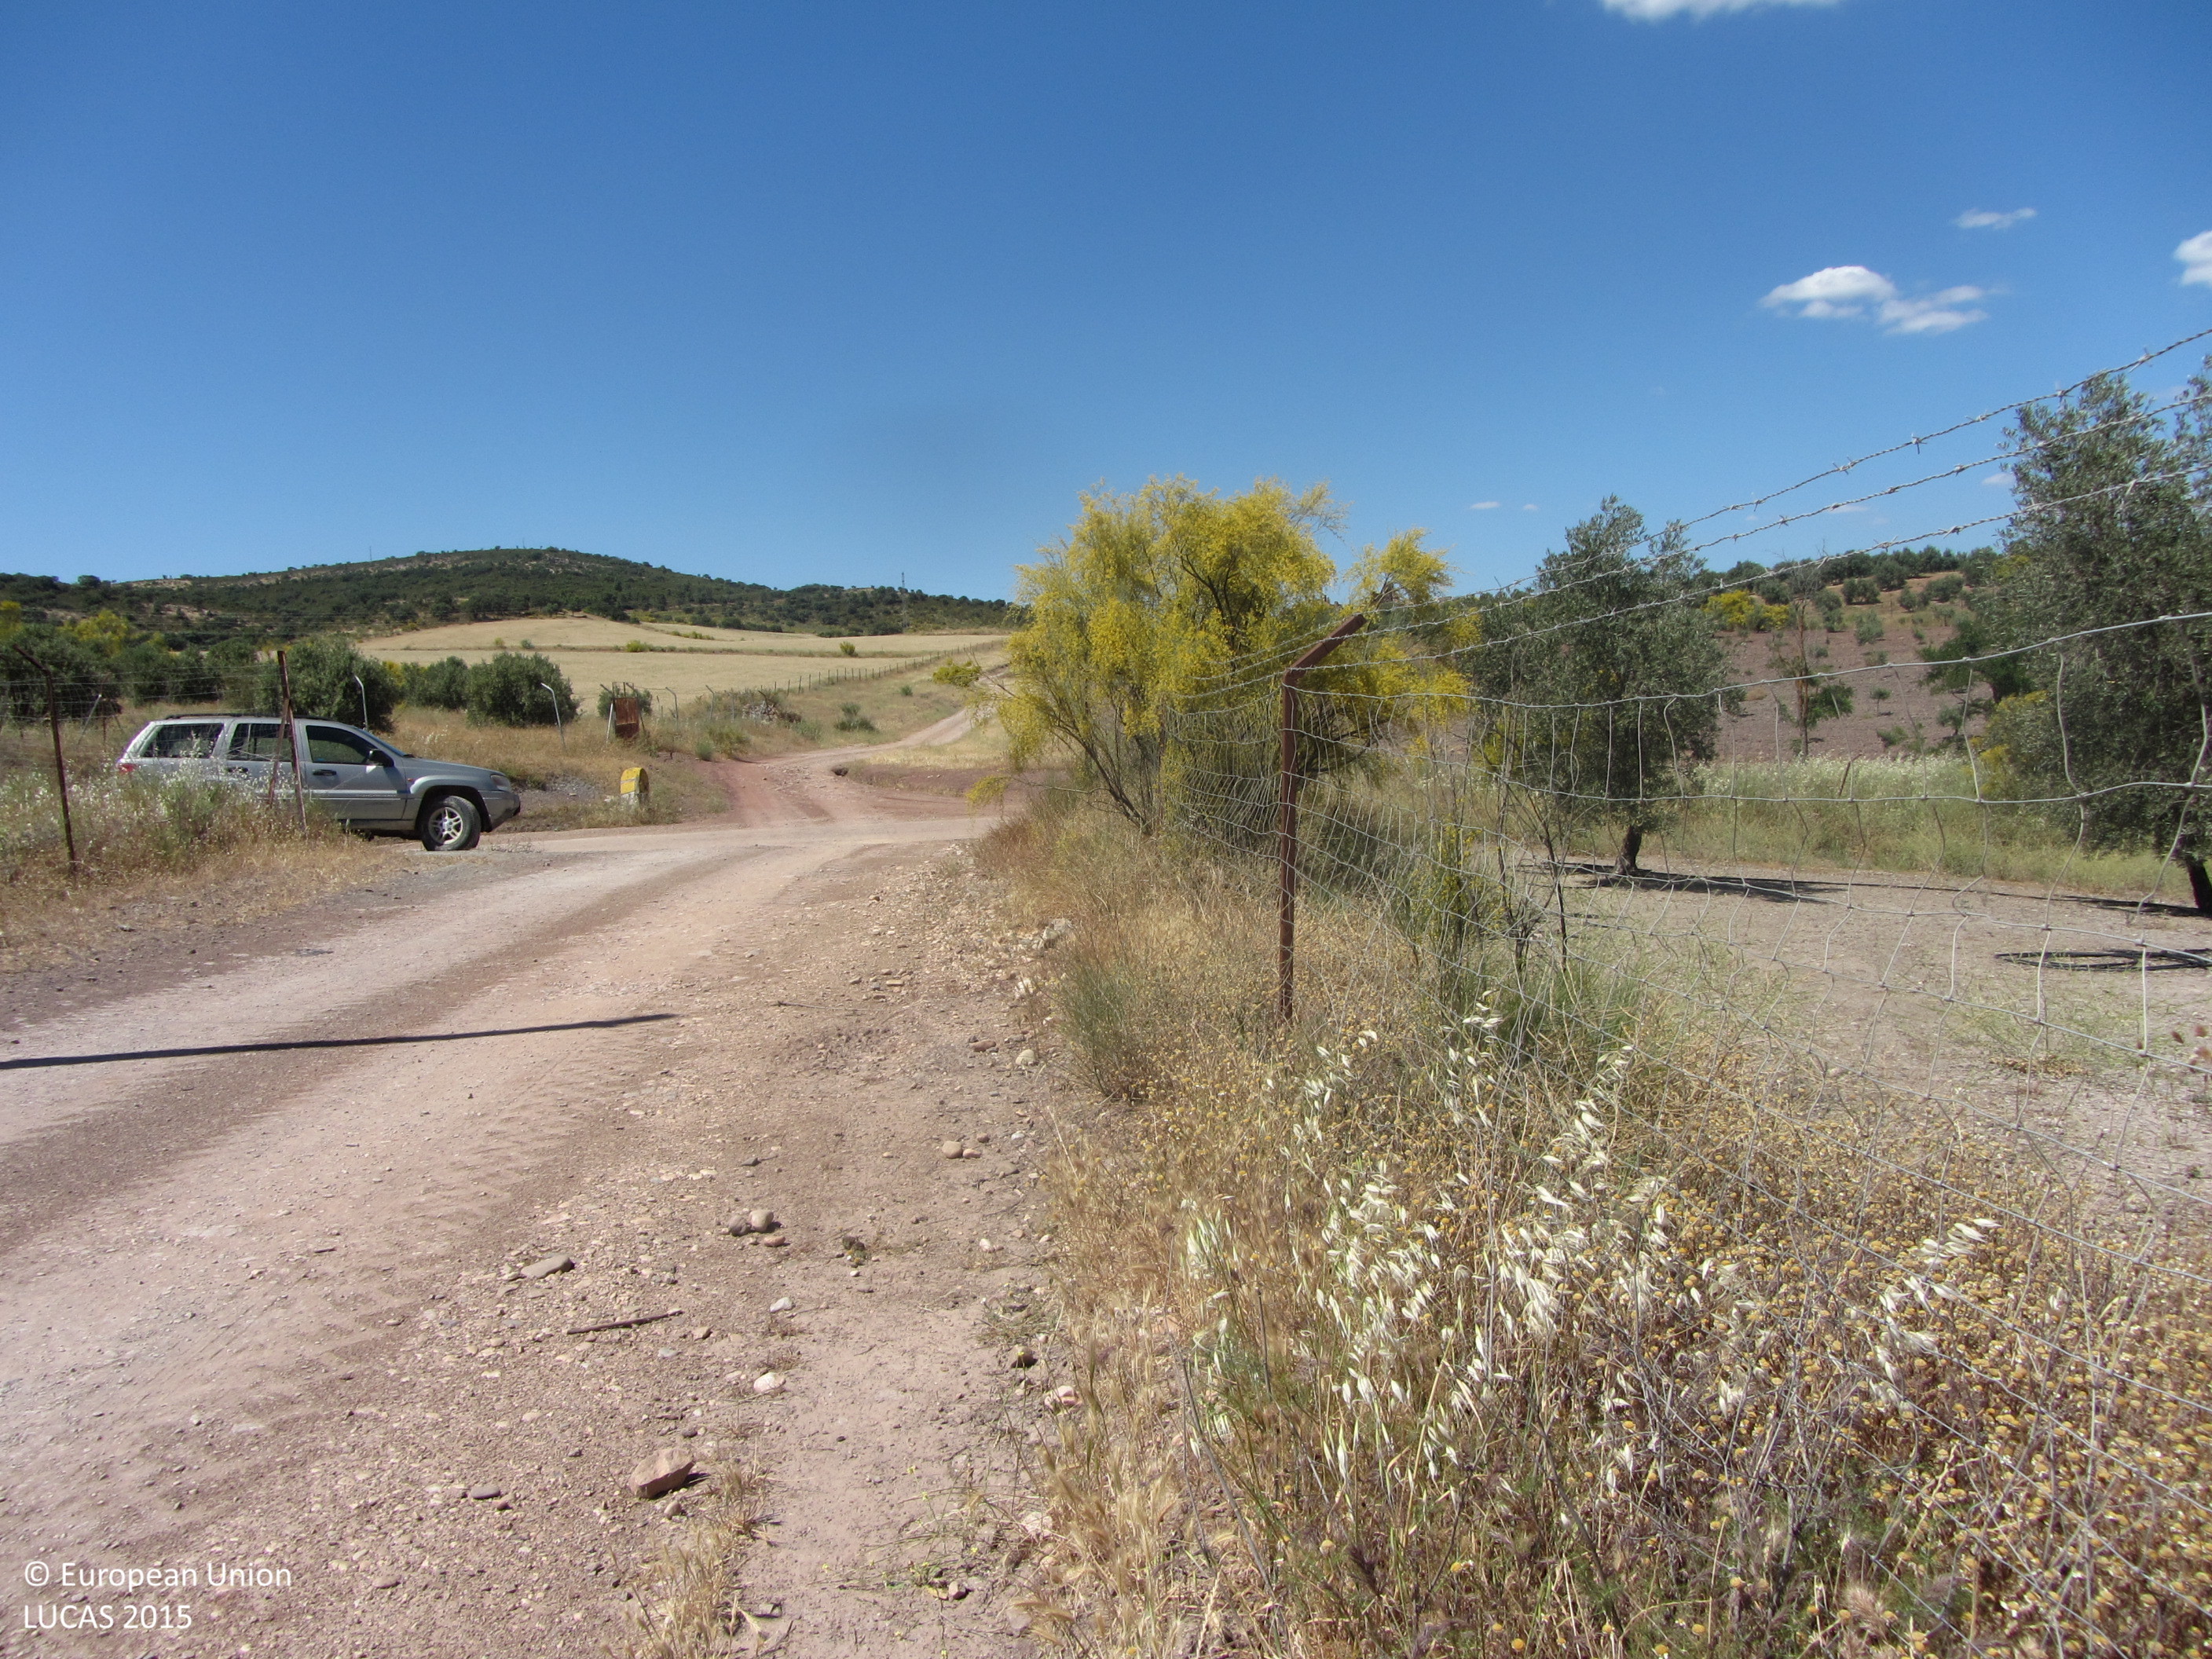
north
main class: Cropland
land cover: Olive groves
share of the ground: 25 - 50 %
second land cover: Other bare soil
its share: > 75 %
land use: Agriculture (excluding fallow land and kitchen gardens)
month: May
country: ES
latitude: 38.3534
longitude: -2.8738
